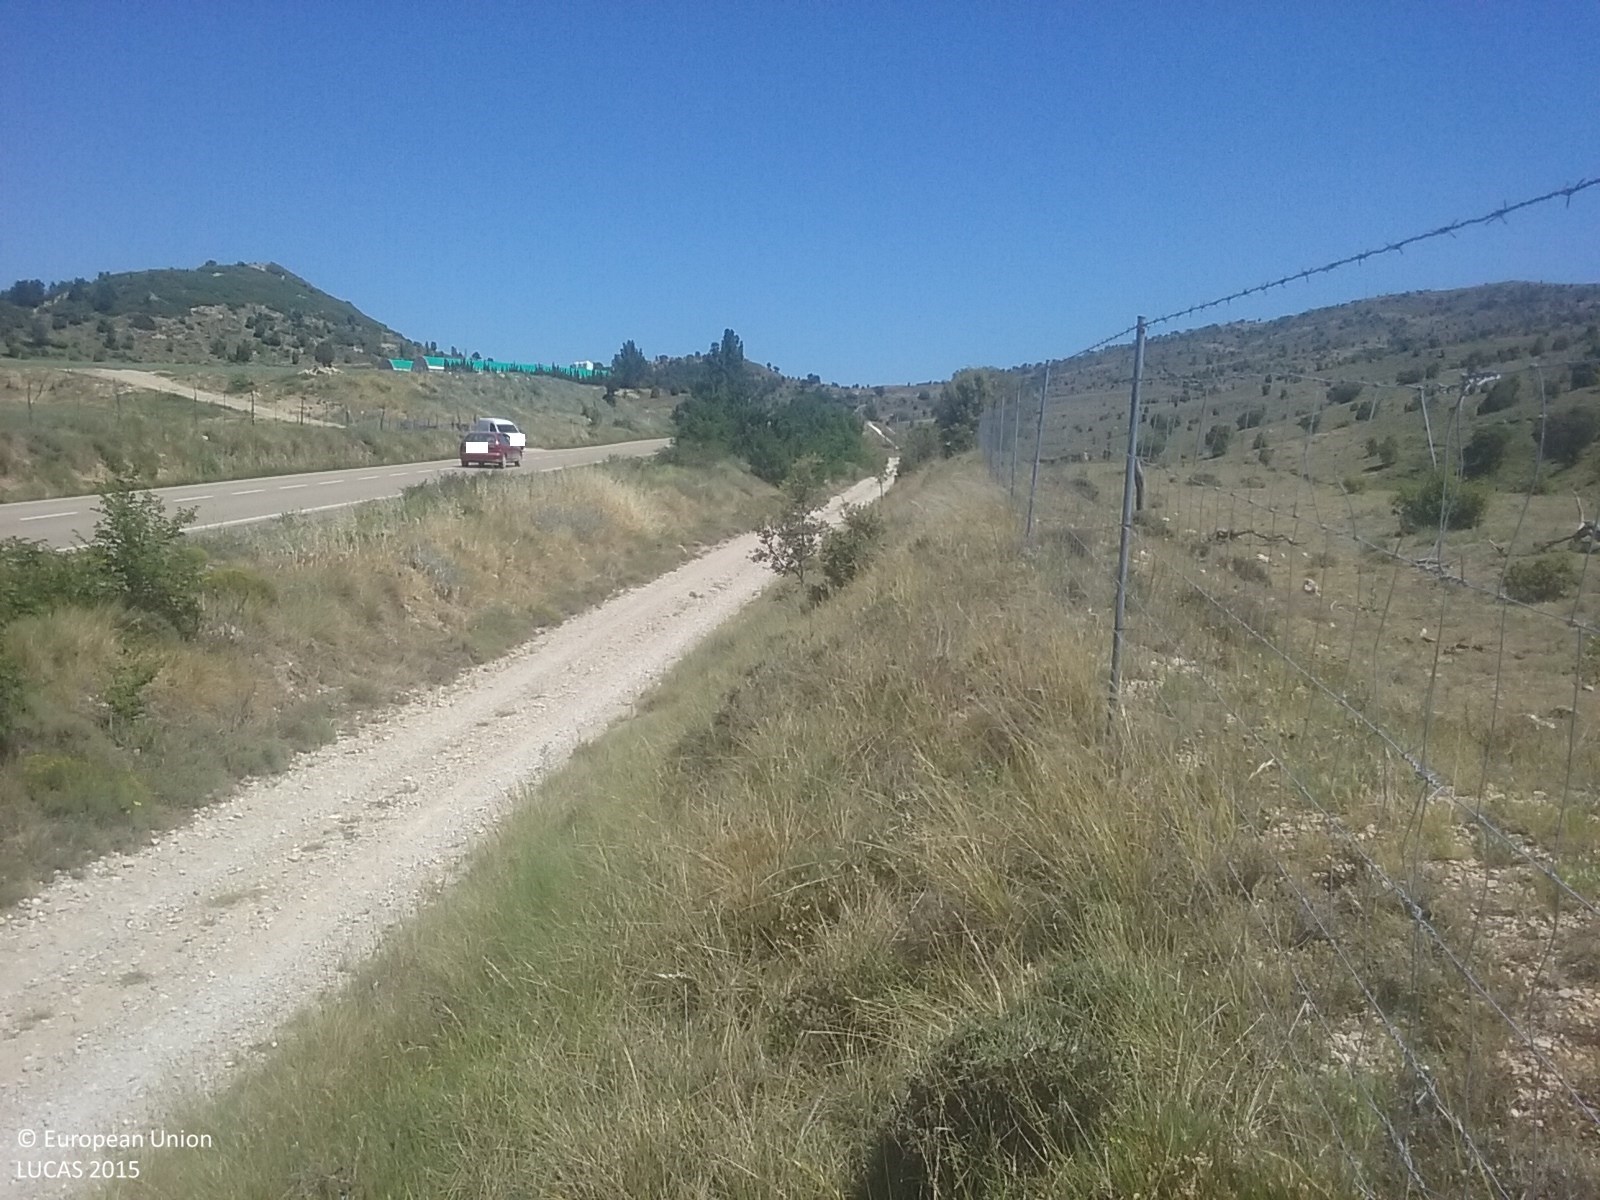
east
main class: Grassland
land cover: Grassland without tree/shrub cover
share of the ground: > 75 %
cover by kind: herbaceous plants 95 %, shrubs 5 %
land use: Agriculture (excluding fallow land and kitchen gardens)
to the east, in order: Grassland without tree/shrub cover; Rivers and streams; Grassland without tree/shrub cover; Electric lines; Grassland without tree/shrub cover; Fences; Grassland without tree/shrub cover; Tracks; Shruby margins; Paved roads, cycling and walking lanes; Grass margins; Fences; Grass margins; Oats
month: June
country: ES
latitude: 40.6047
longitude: -0.0642
